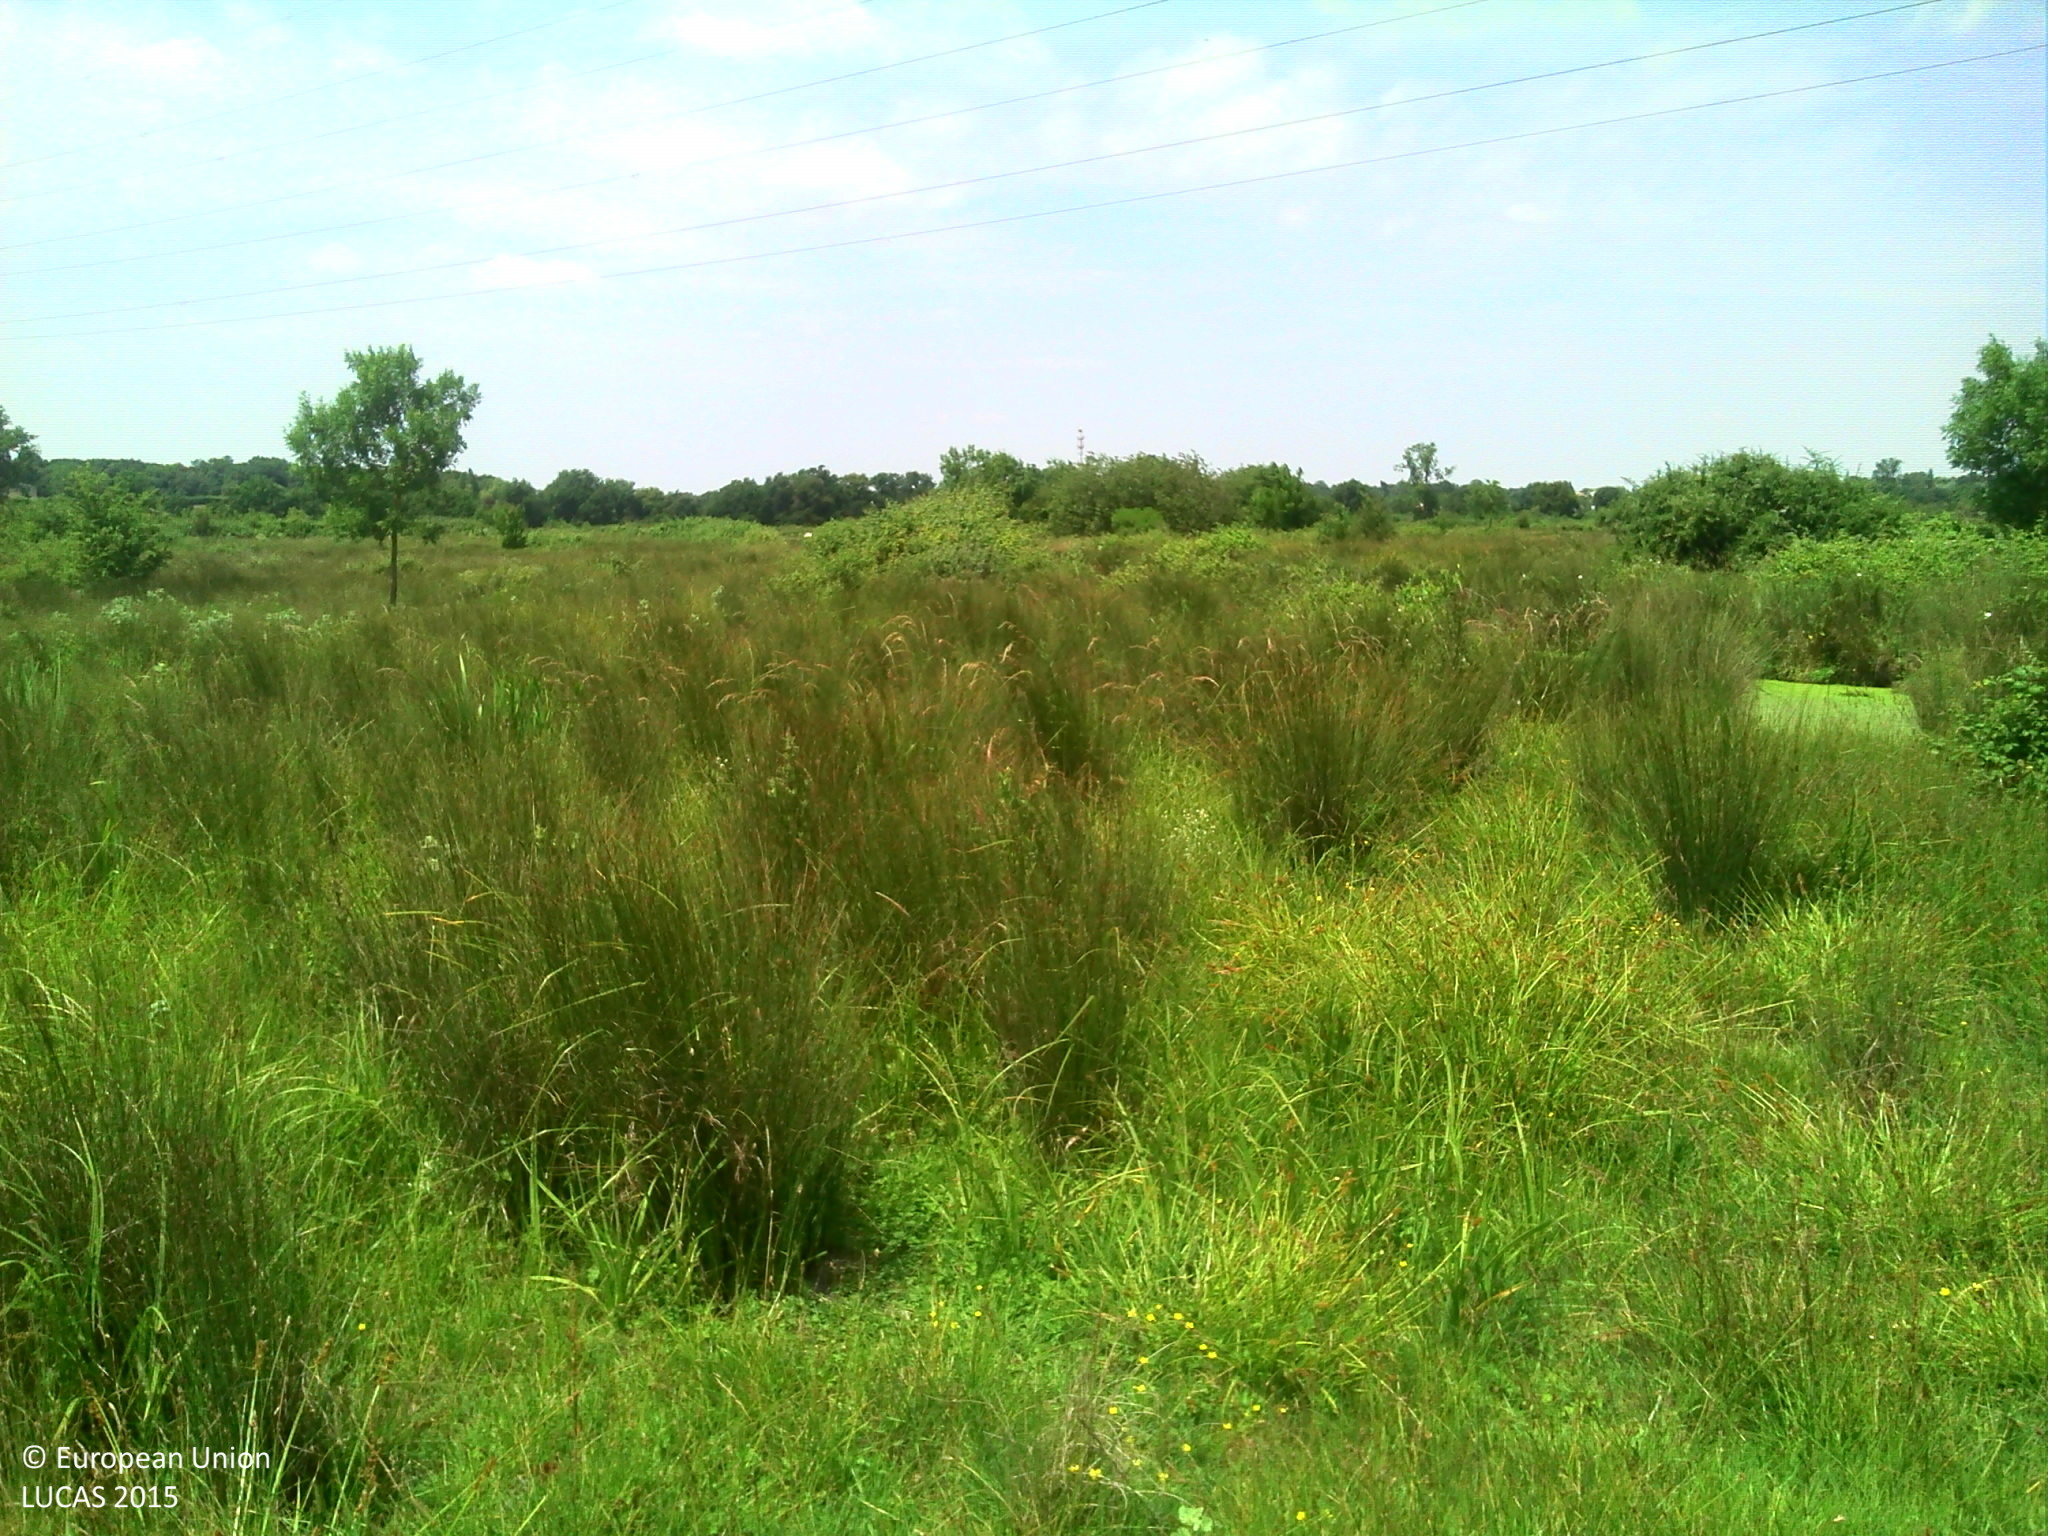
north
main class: Grassland
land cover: Grassland without tree/shrub cover
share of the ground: > 75 %
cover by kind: herbaceous plants 95 %, shrubs 5 %
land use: Agriculture (excluding fallow land and kitchen gardens)
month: June
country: FR
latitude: 45.9680
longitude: -0.9593
